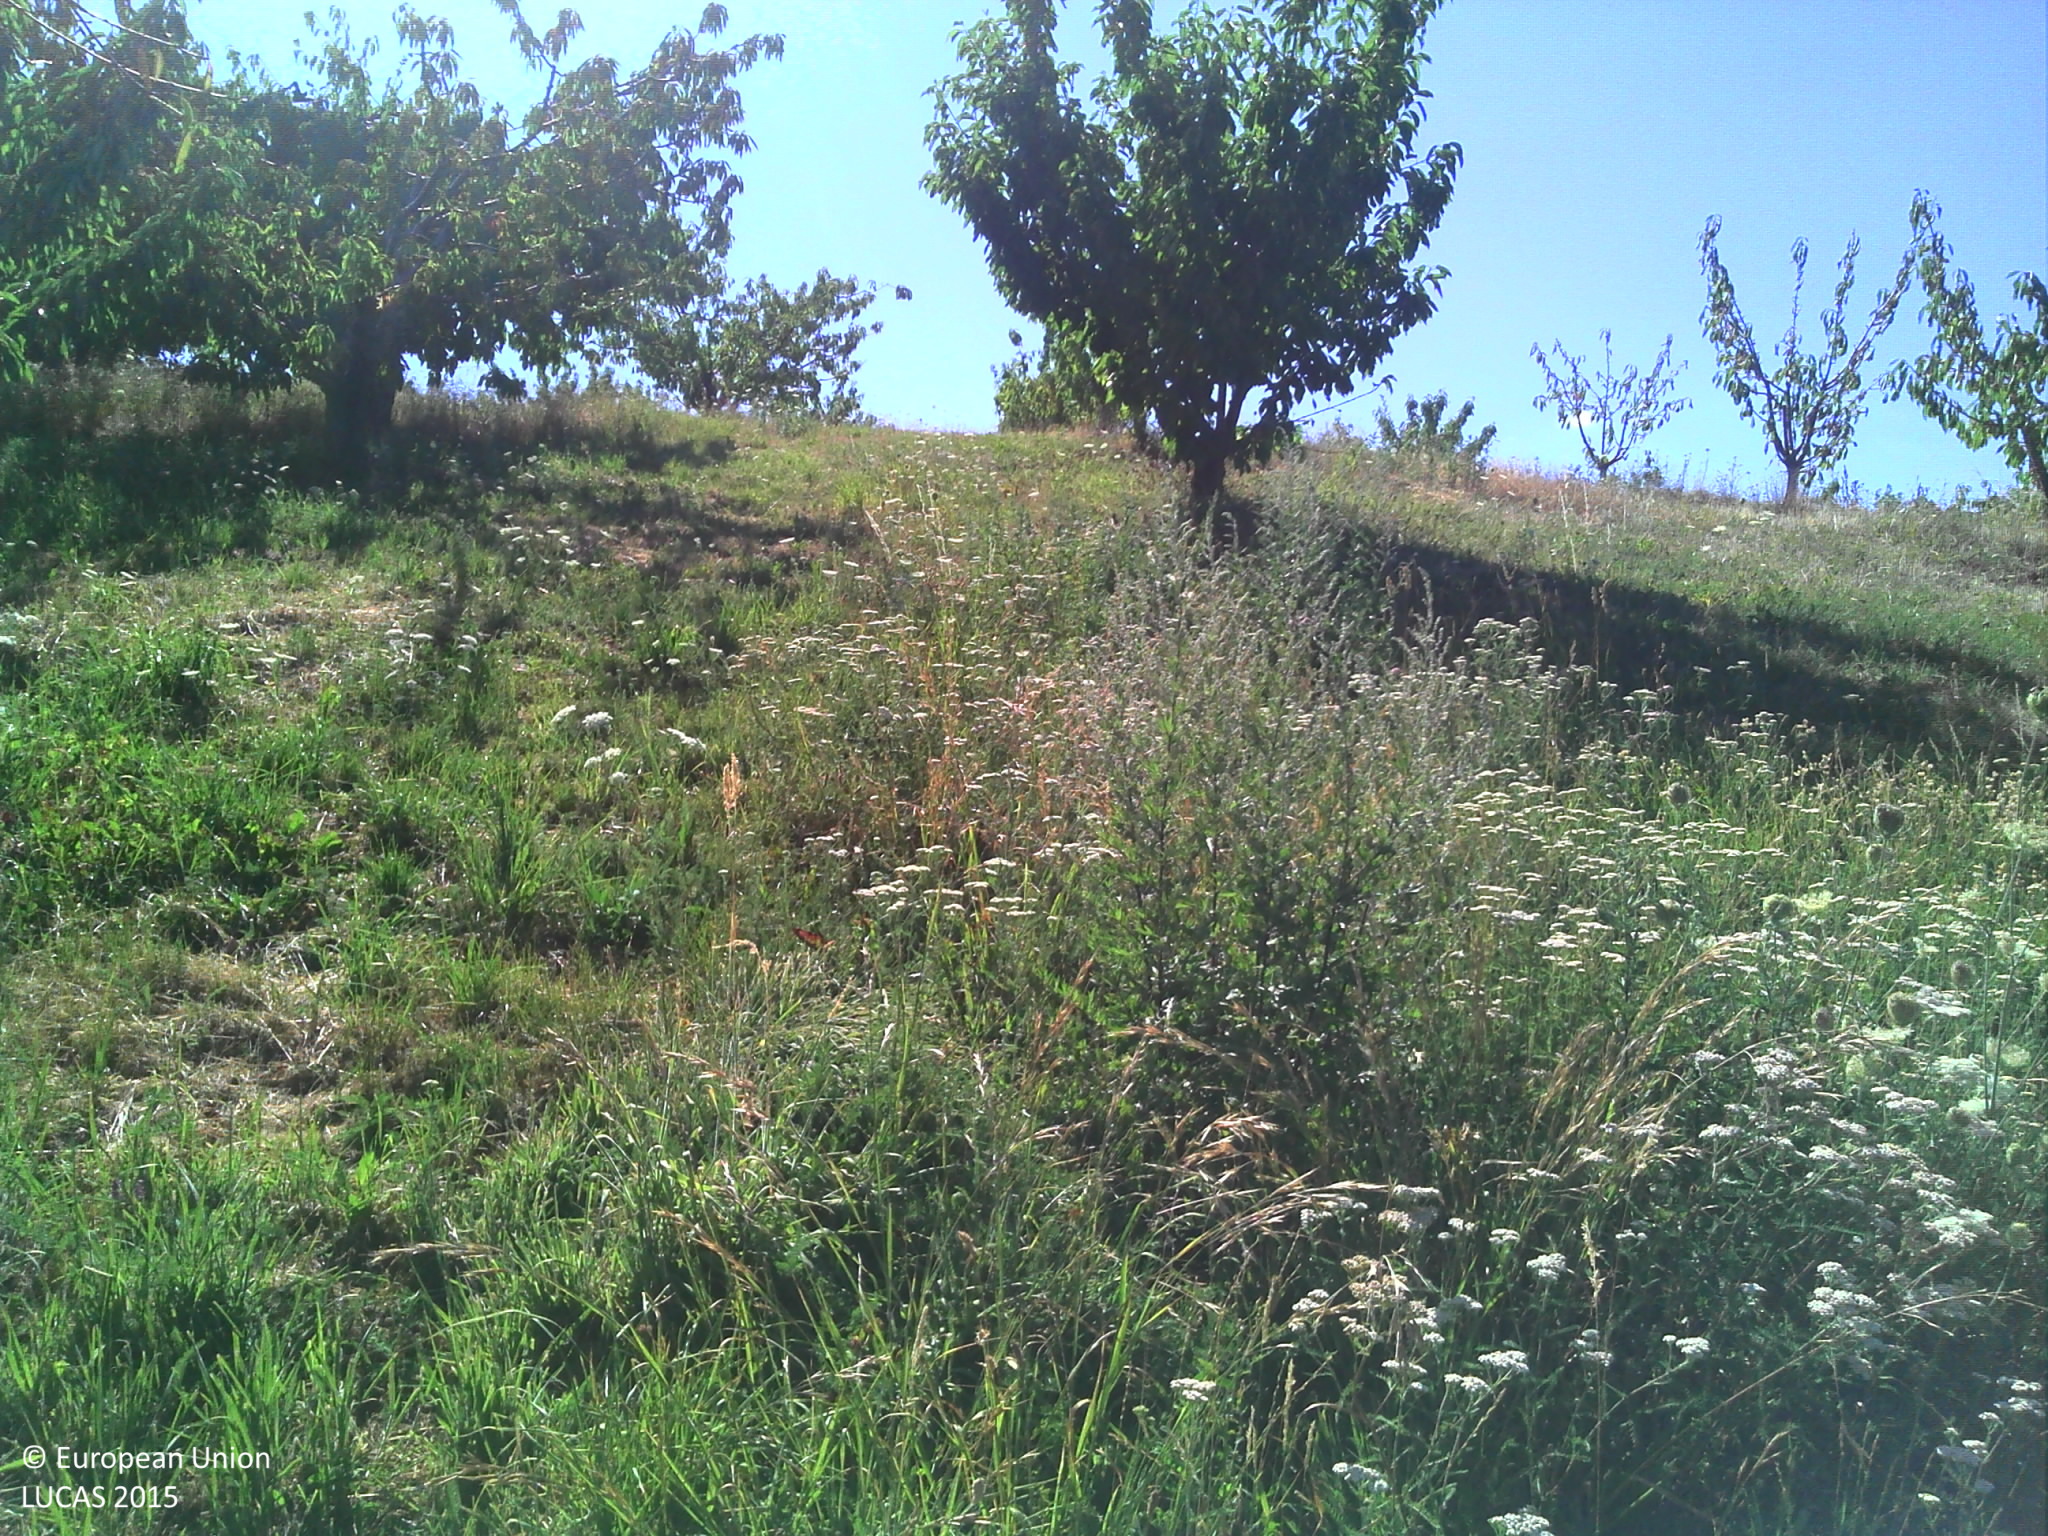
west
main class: Cropland
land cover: Cherry fruit
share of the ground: > 75 %
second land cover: Grassland without tree/shrub cover
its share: > 75 %
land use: Agriculture (excluding fallow land and kitchen gardens)
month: July
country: FR
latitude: 44.9478
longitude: 4.5427
